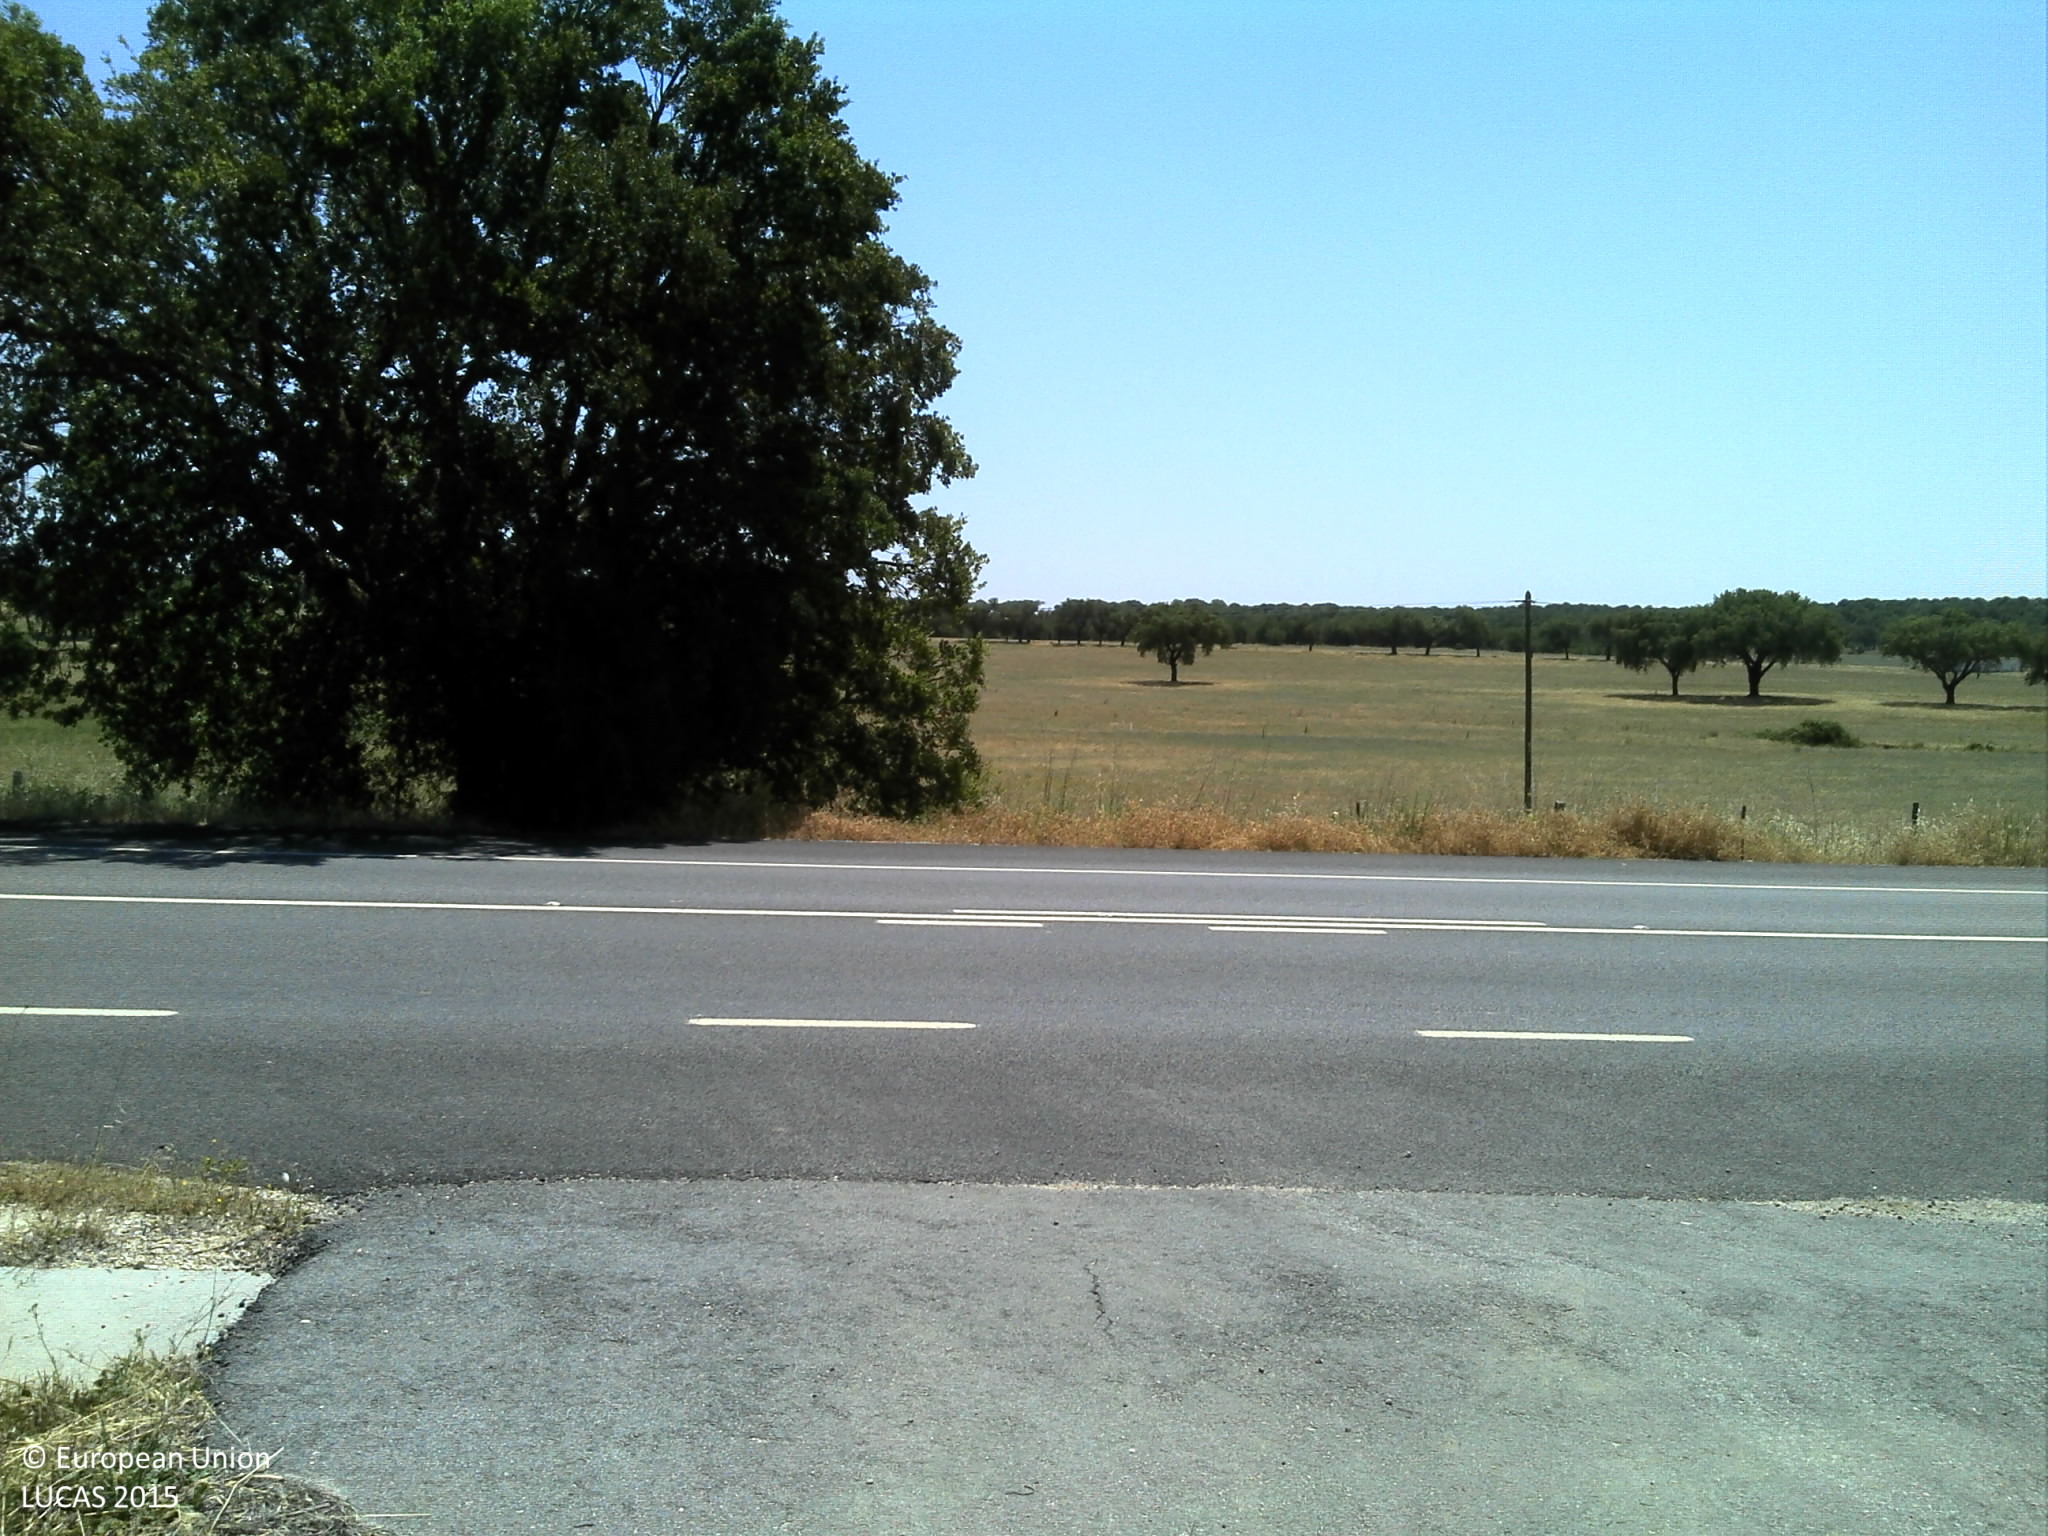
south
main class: Cropland
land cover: Olive groves
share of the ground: 25 - 50 %
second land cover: Grassland without tree/shrub cover
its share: > 75 %
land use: Agriculture (excluding fallow land and kitchen gardens)
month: May
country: PT
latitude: 38.7907
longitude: -7.8999
